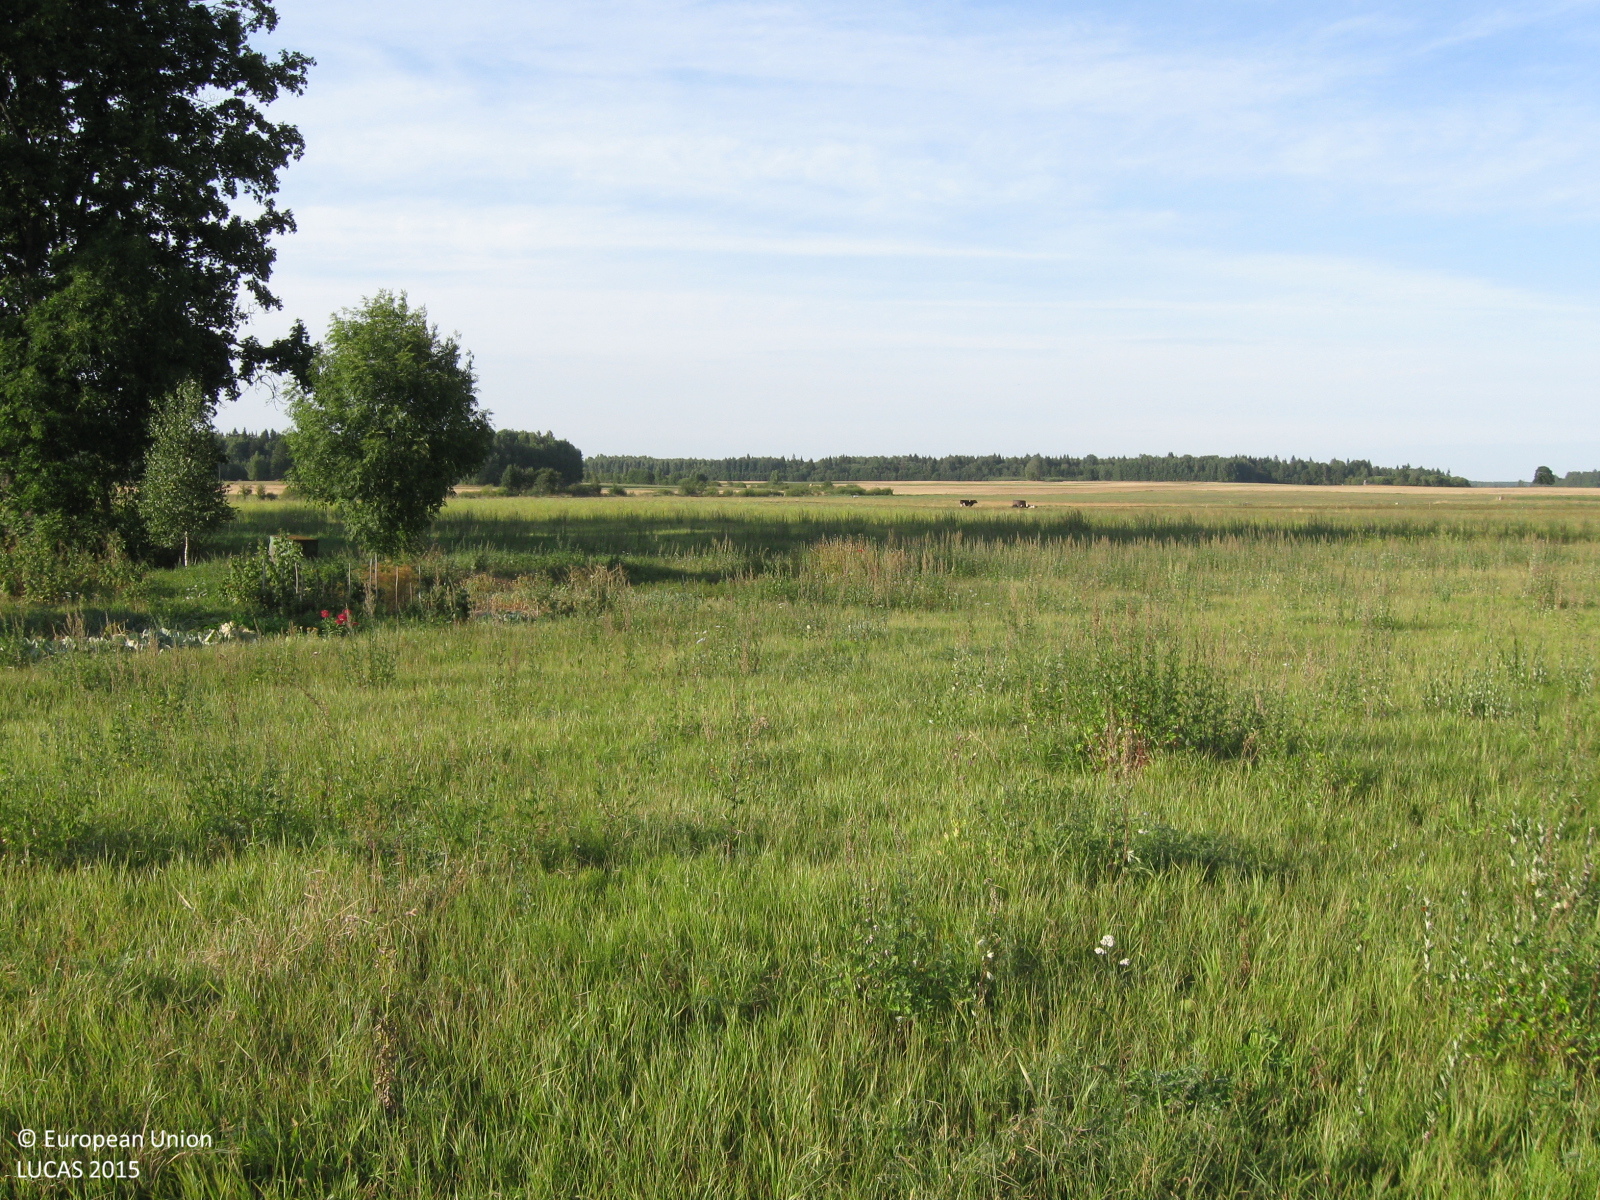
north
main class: Grassland
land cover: Grassland without tree/shrub cover
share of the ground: > 75 %
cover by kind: herbaceous plants 100 %
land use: Agriculture (excluding fallow land and kitchen gardens)
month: August
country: LT
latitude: 55.4009
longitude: 23.2924
